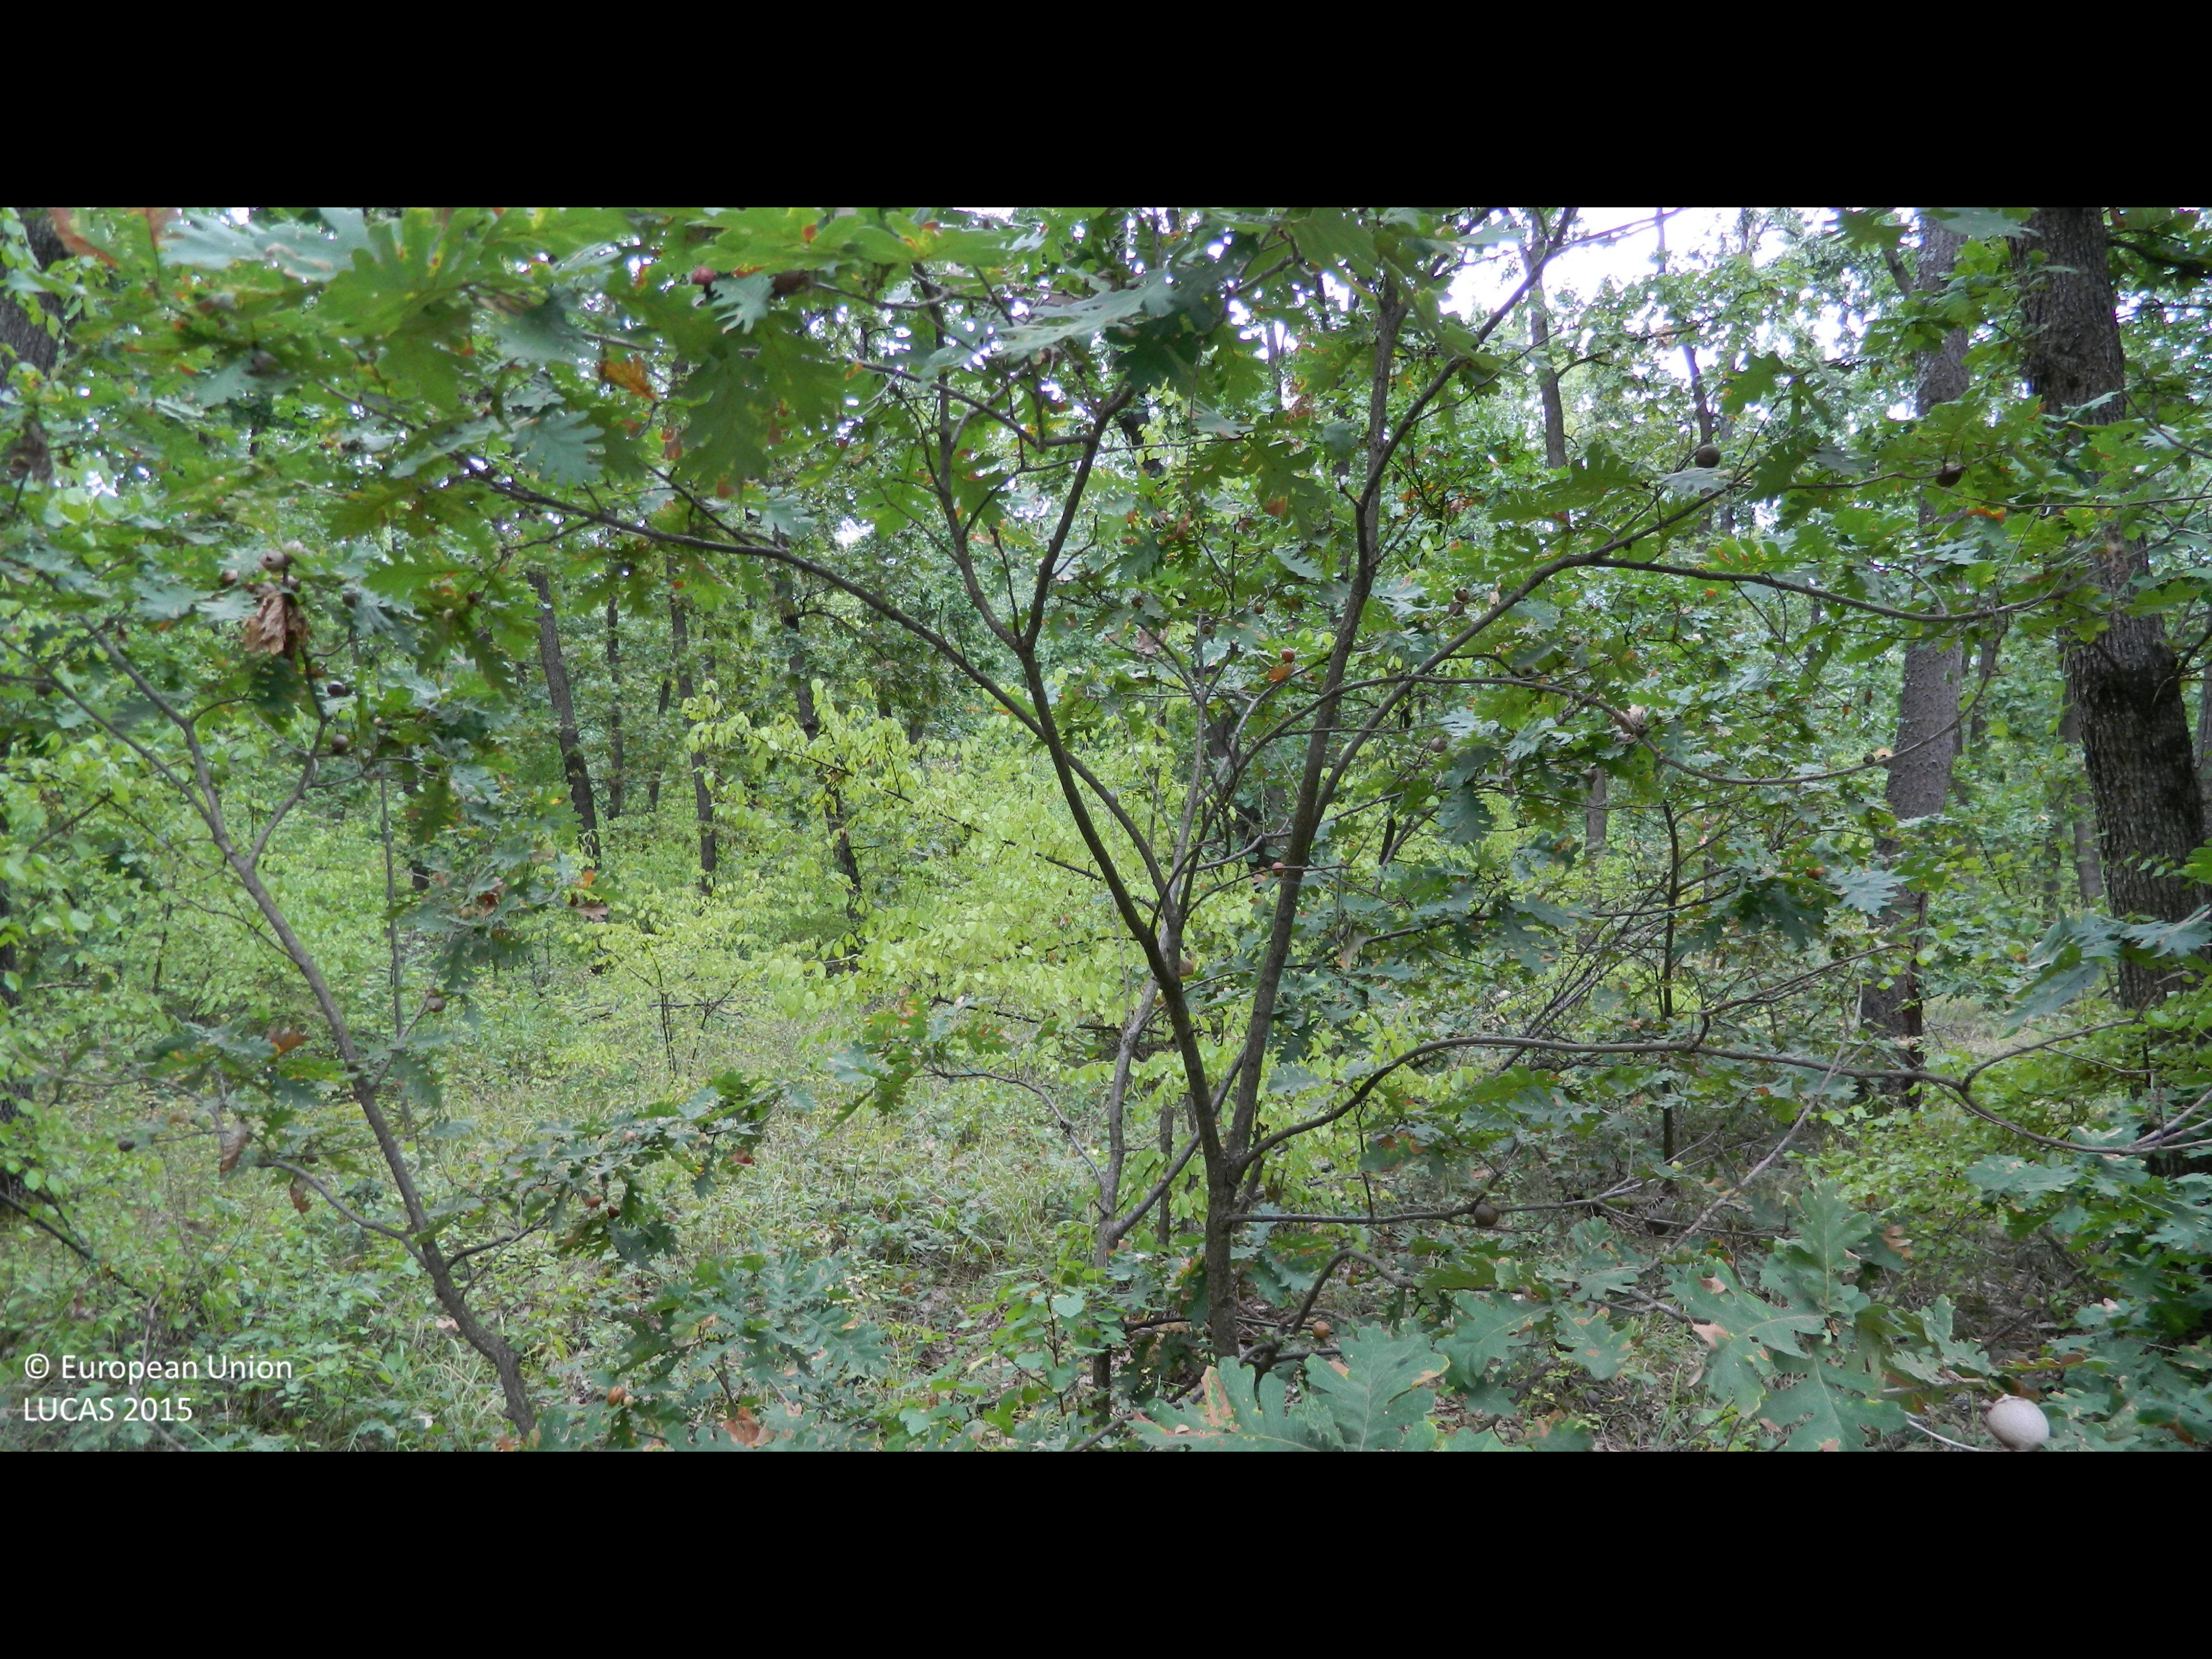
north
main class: Woodland
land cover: Broadleaved woodland
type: mesophytic deciduous forest
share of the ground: > 75 %
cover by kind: broadleaved forest trees 85 %, herbaceous plants 10 %, shrubs 5 %
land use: Forestry
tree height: > 5 m
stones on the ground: < 10 %
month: September
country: BG
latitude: 41.7358
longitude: 25.6824
